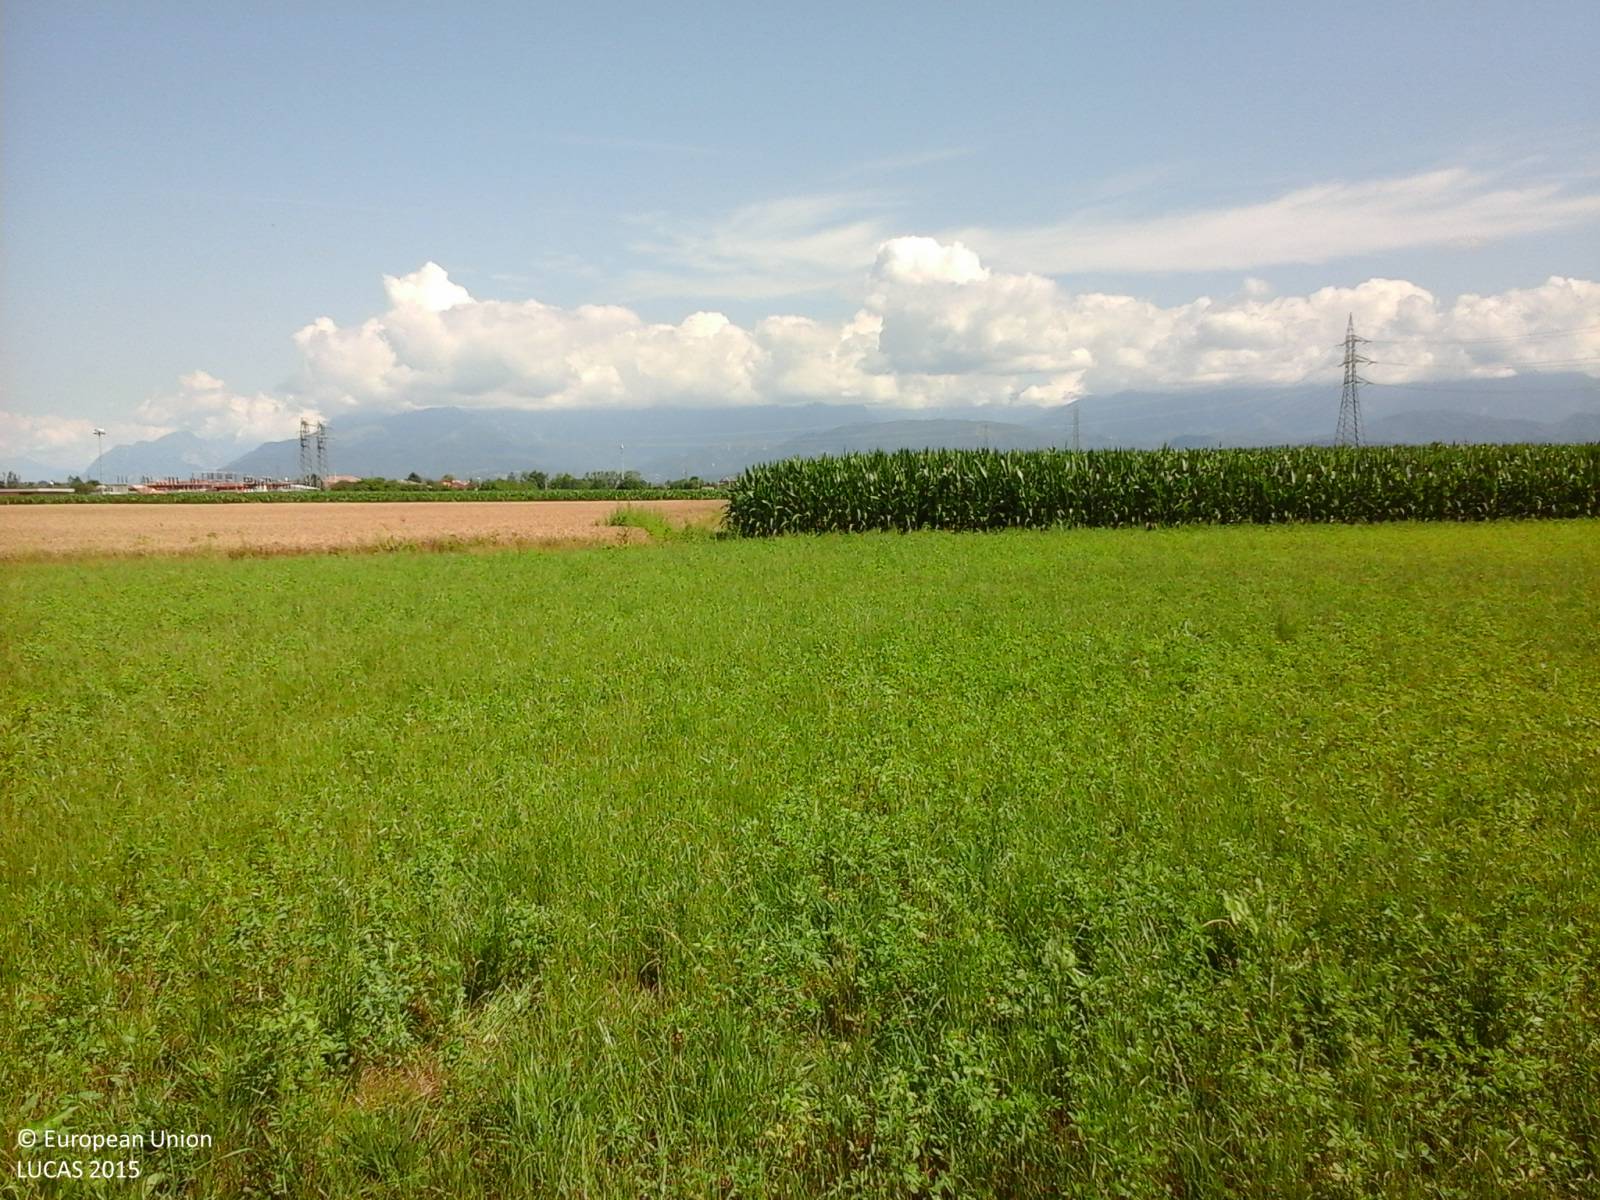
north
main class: Cropland
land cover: Lucerne
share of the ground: > 75 %
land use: Agriculture (excluding fallow land and kitchen gardens)
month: June
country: IT
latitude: 46.1037
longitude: 13.2436
